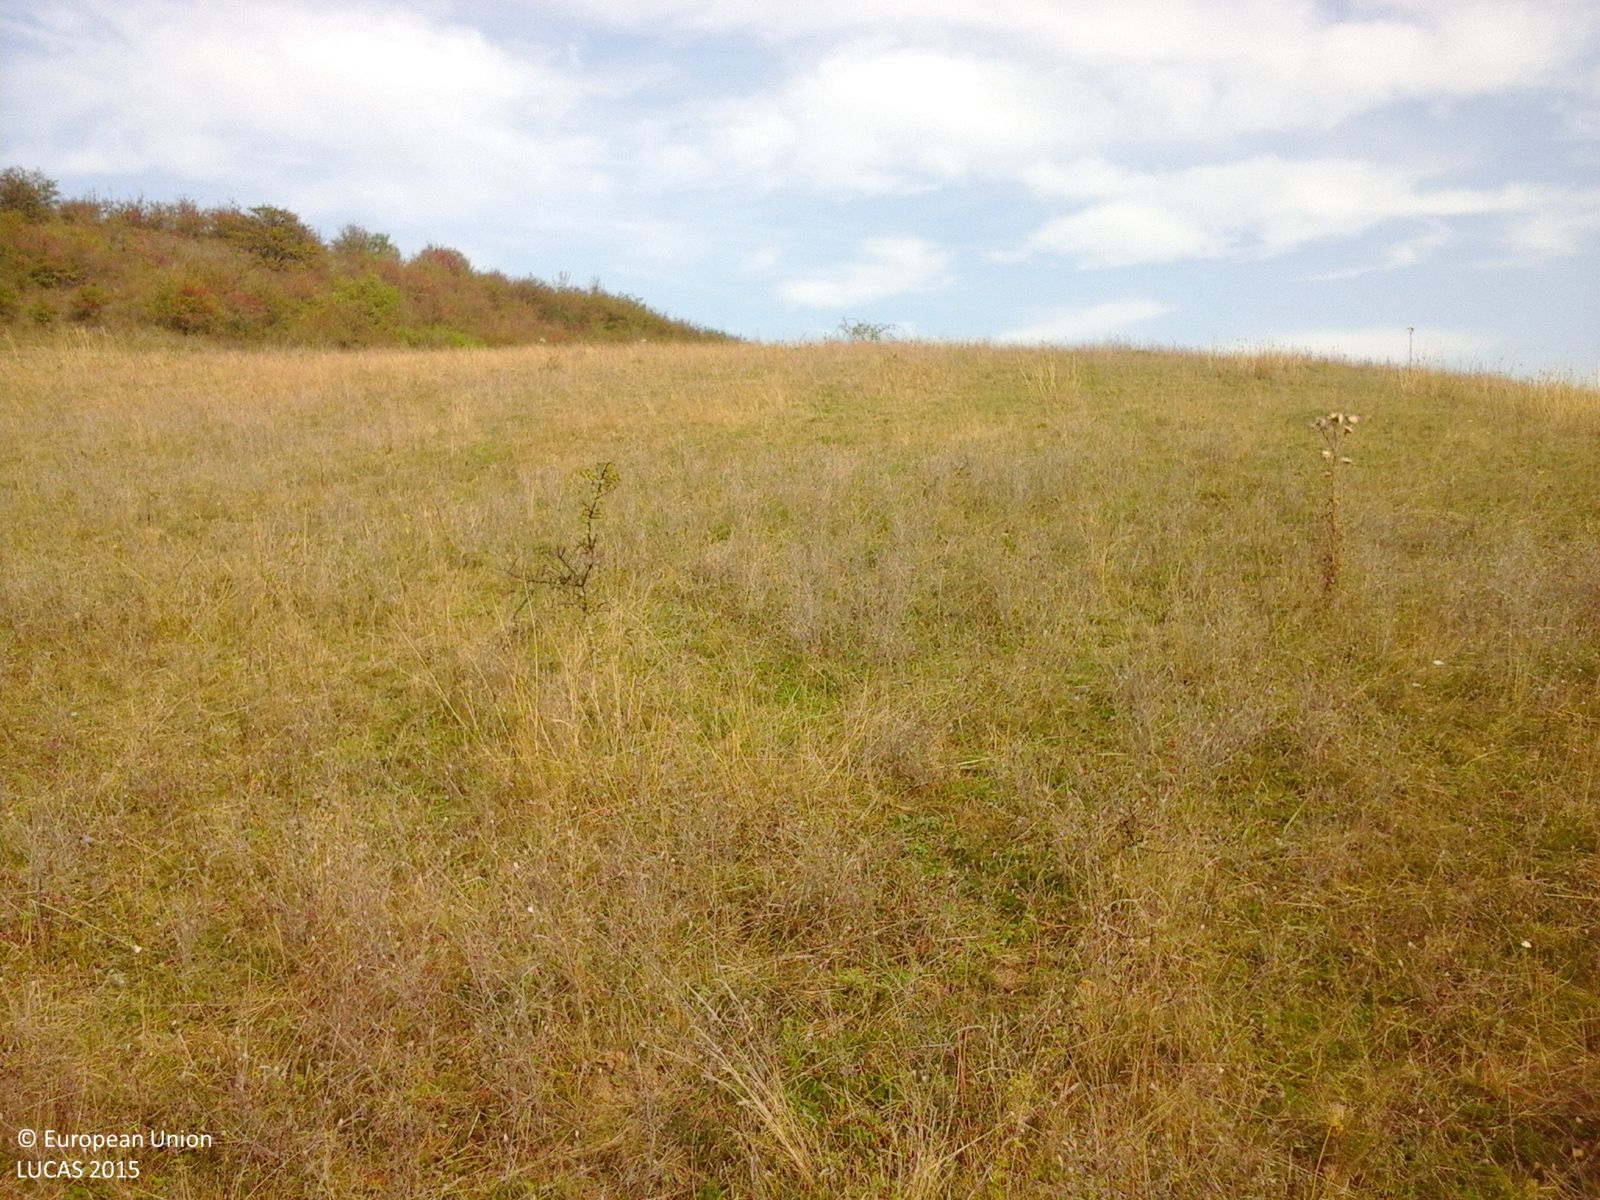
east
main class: Grassland
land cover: Grassland with sparse tree/shrub cover
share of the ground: > 75 %
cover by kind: herbaceous plants 85 %, shrubs 10 %, broadleaved forest trees 5 %
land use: Agriculture (excluding fallow land and kitchen gardens)
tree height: > 5 m
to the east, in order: Grassland with sparse tree/shrub cover; Shrubland with sparse tree cover; Grassland without tree/shrub cover
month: September
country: RO
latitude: 47.1191
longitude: 23.6098
